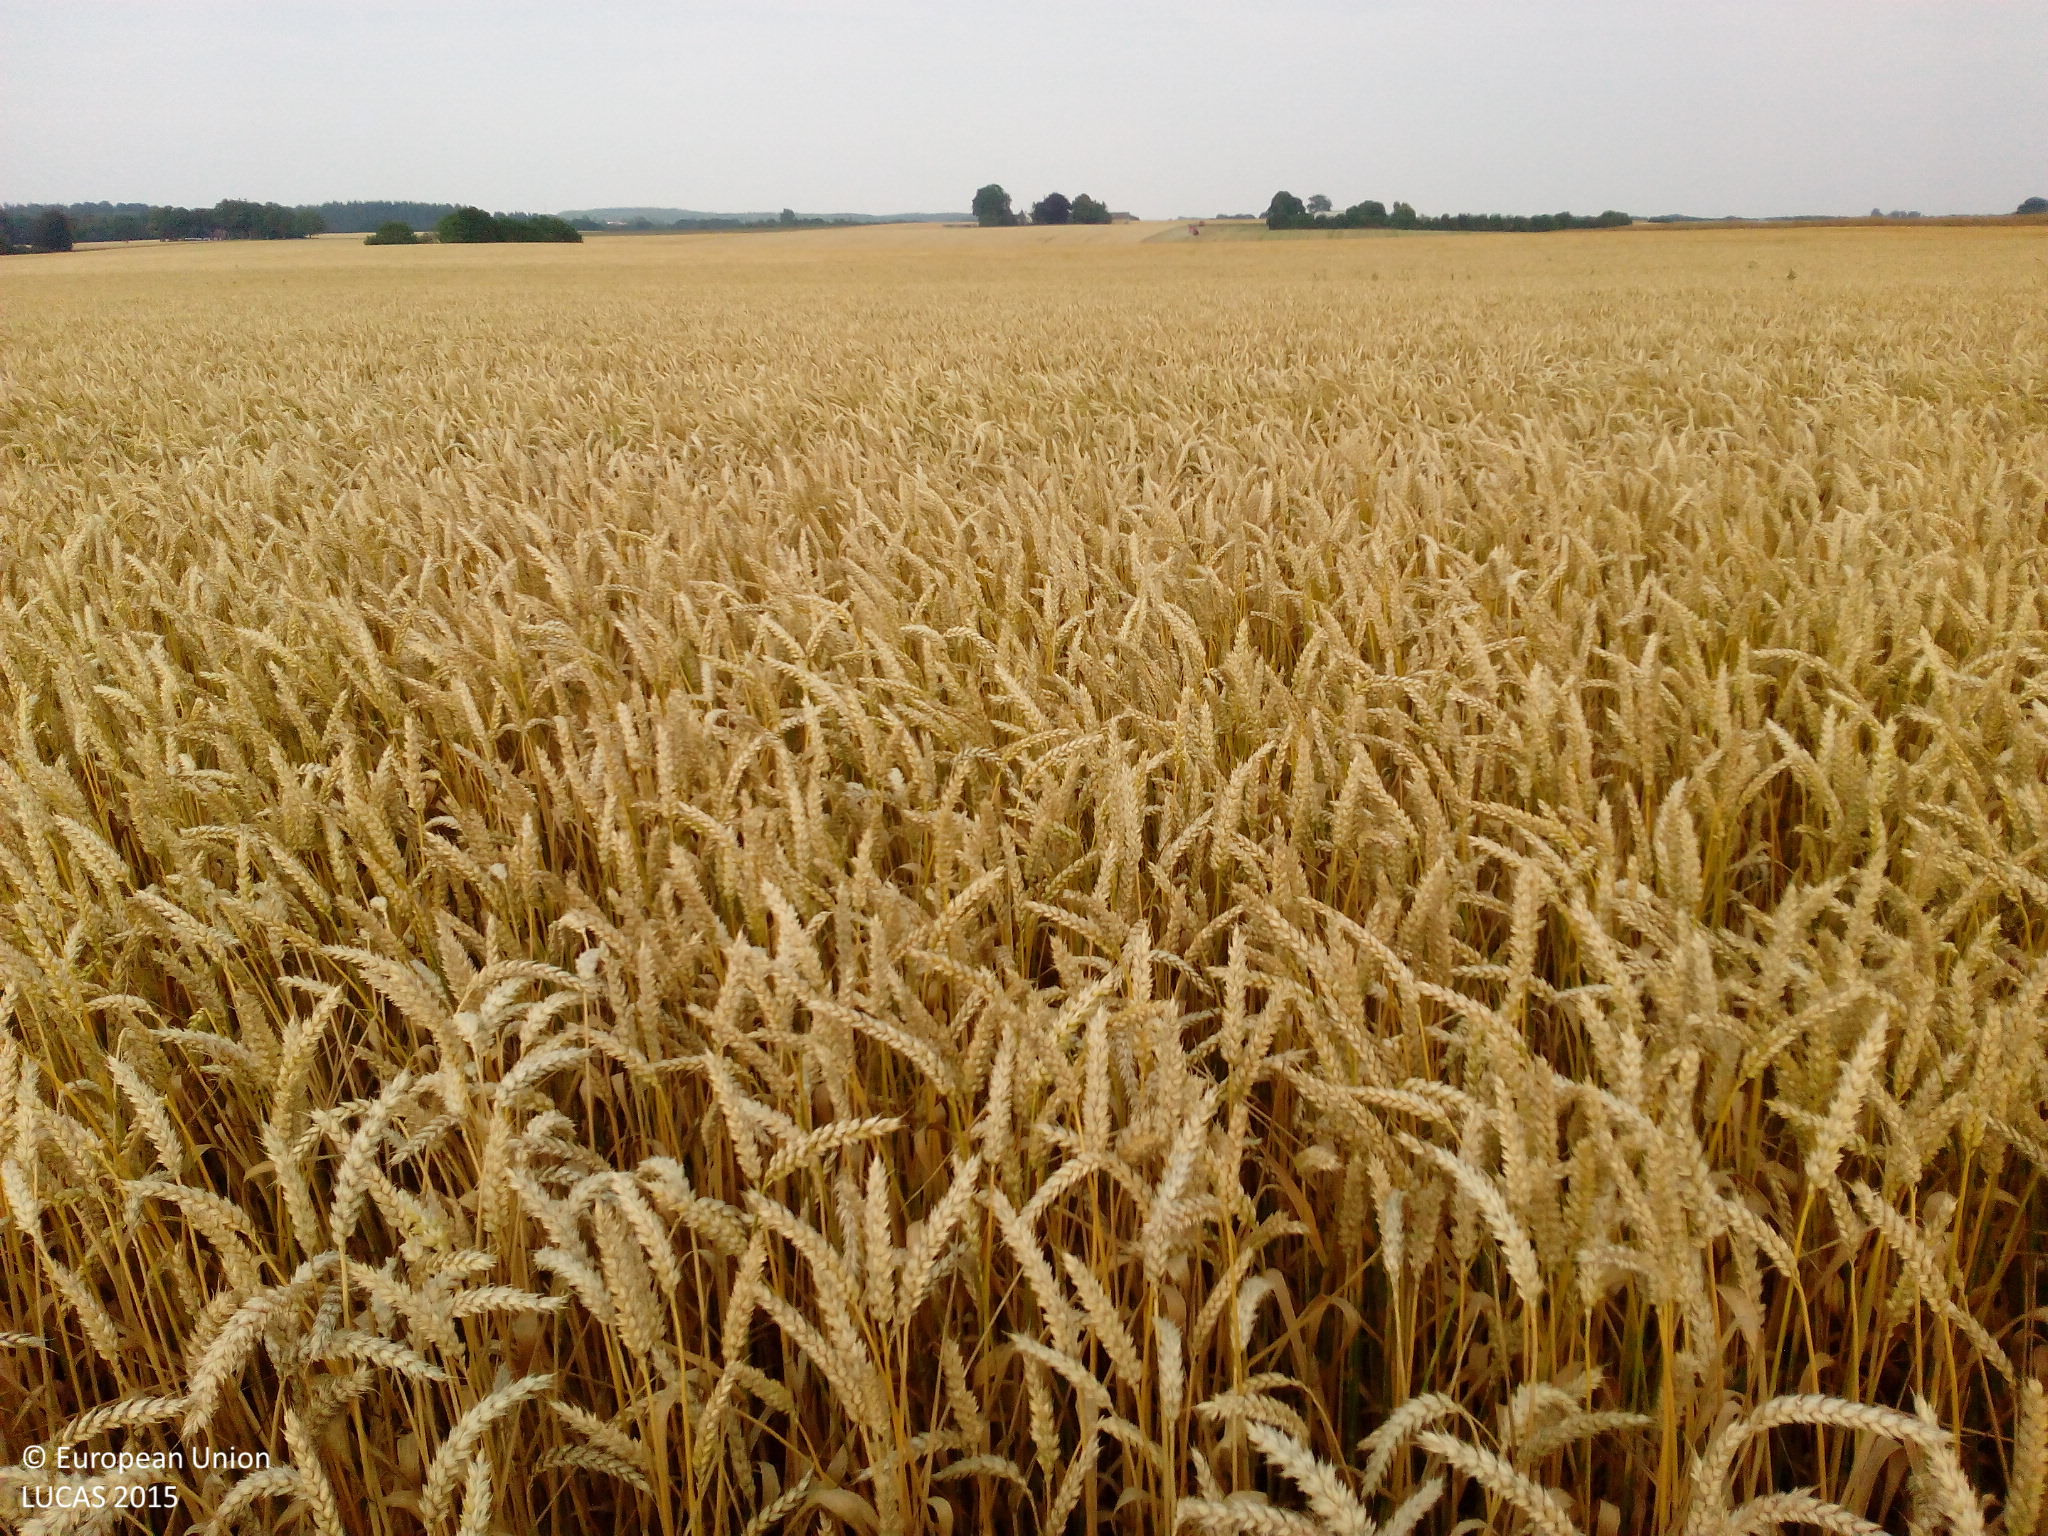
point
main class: Cropland
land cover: Common wheat
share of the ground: > 75 %
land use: Agriculture (excluding fallow land and kitchen gardens)
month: August
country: DK
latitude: 55.4741
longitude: 11.7862
